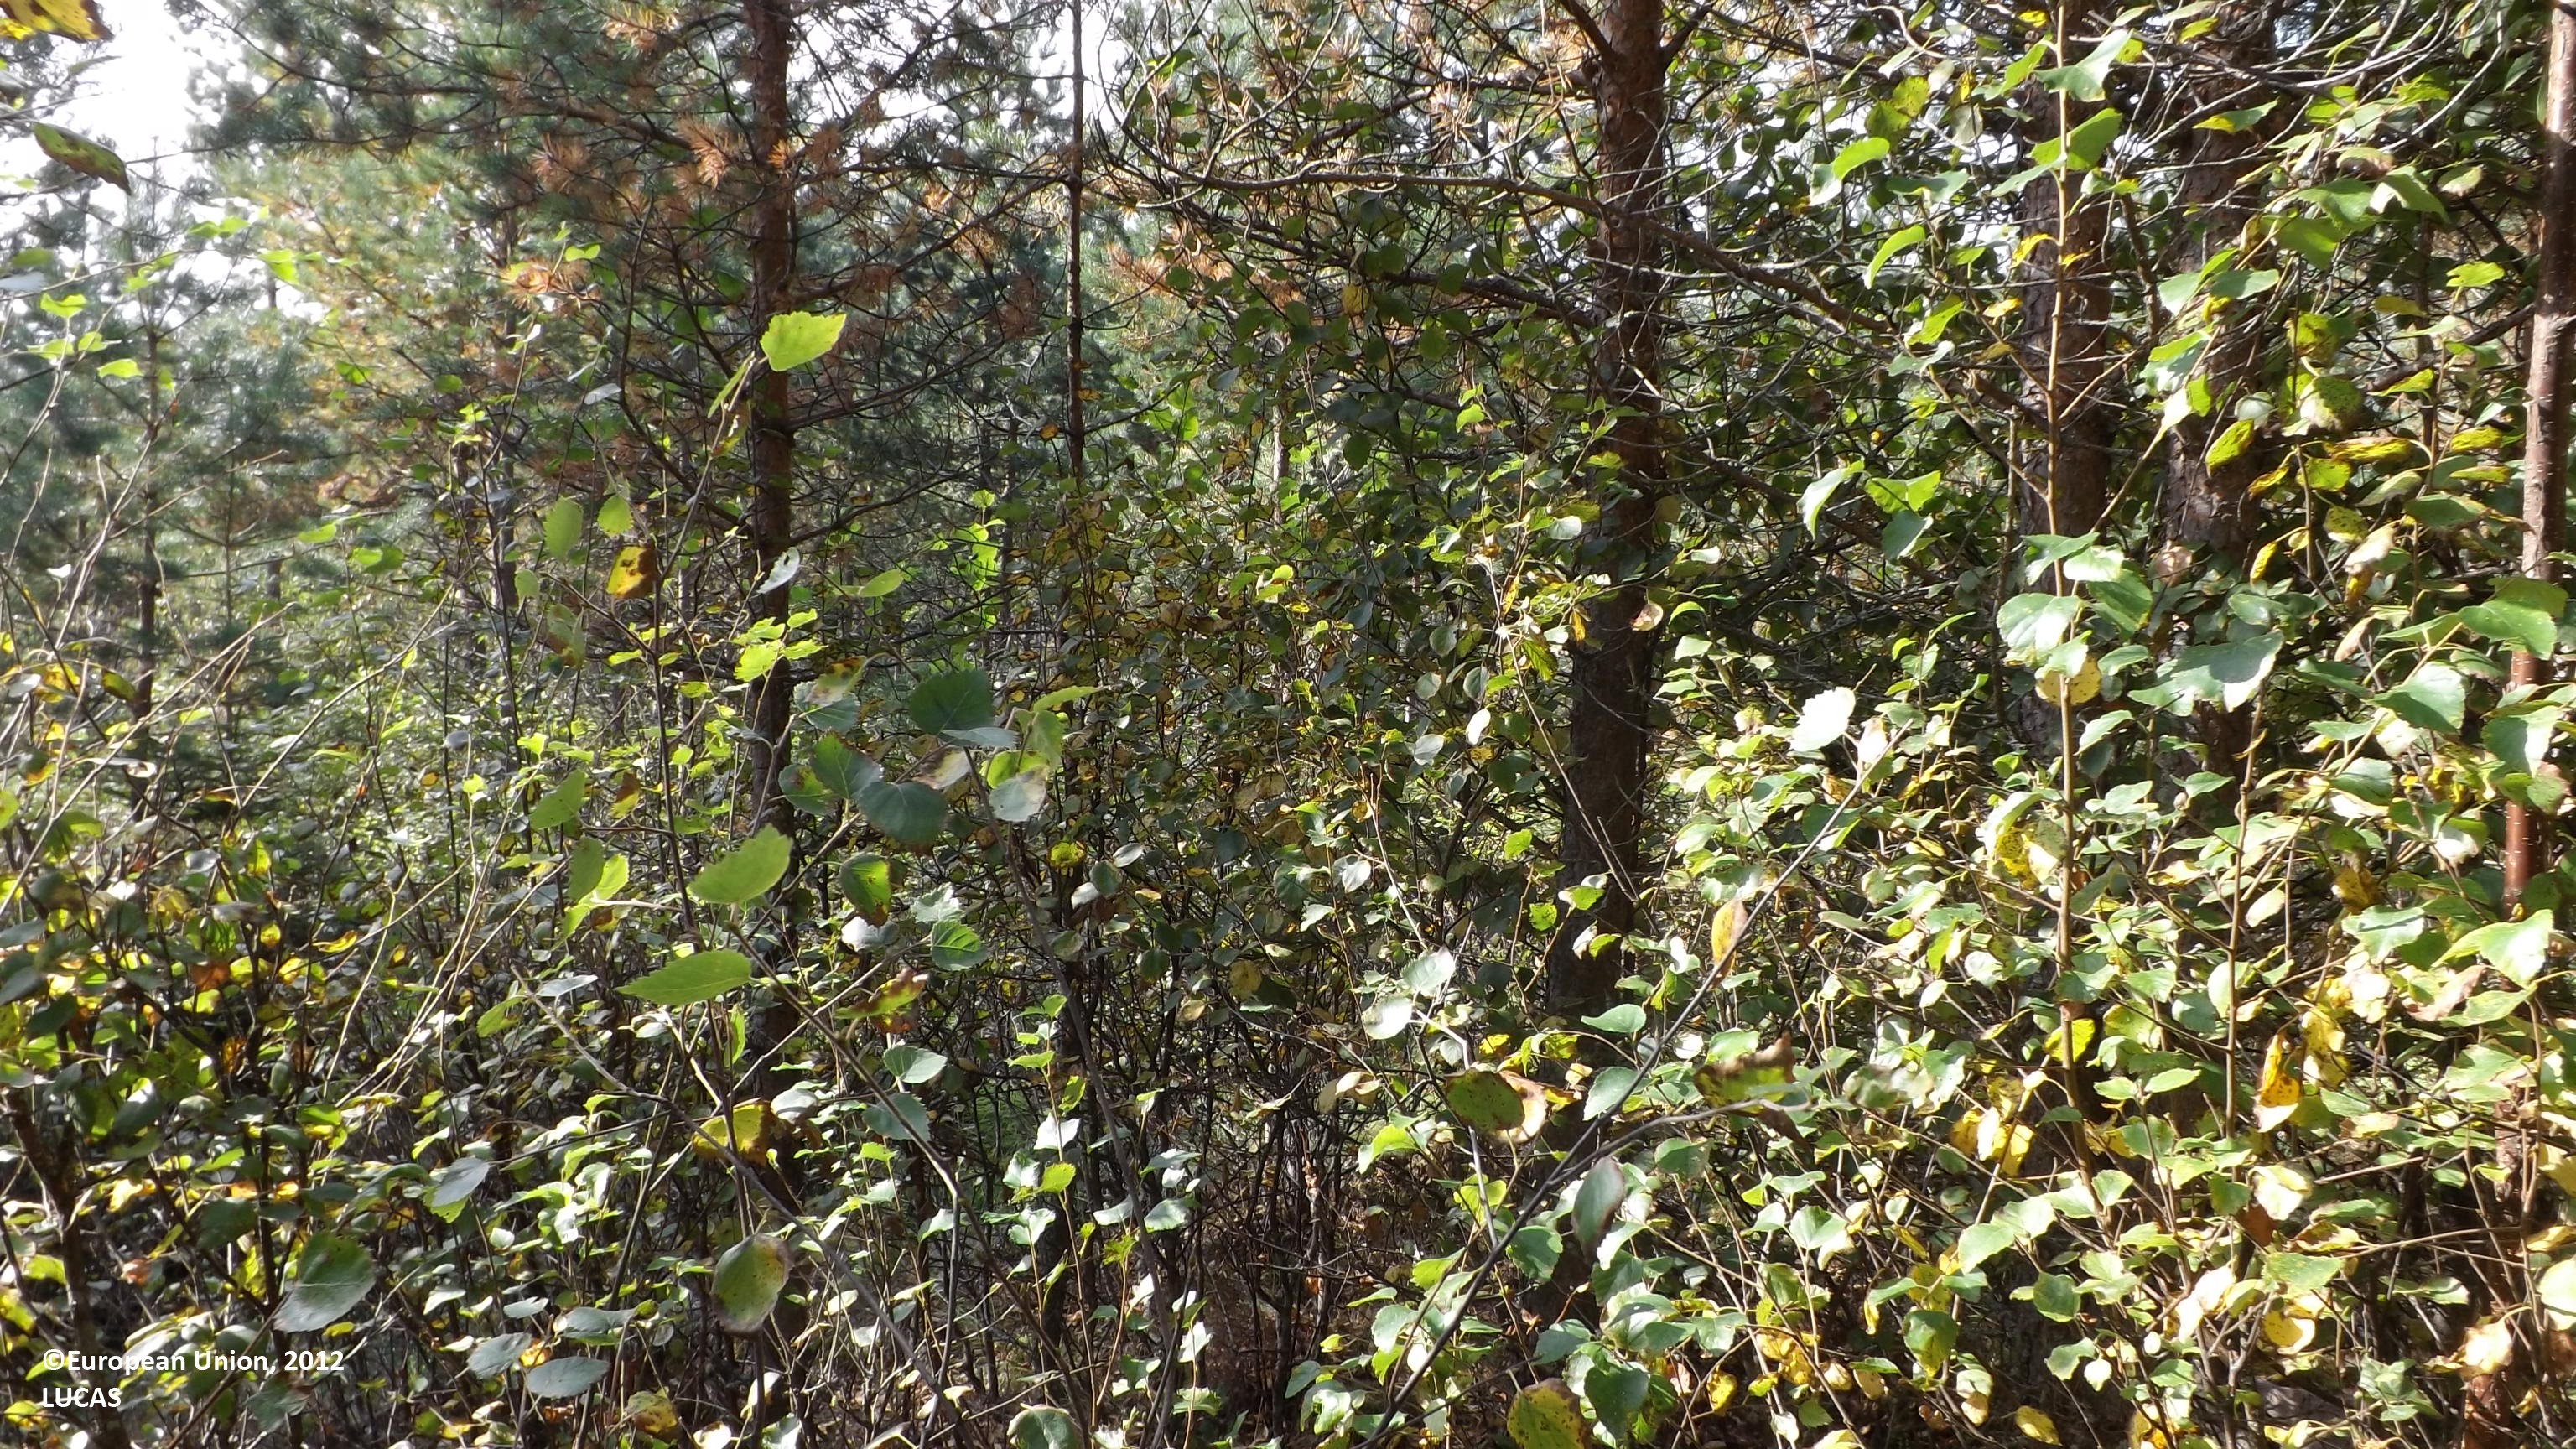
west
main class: Woodland
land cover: Pine dominated coniferous woodland
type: boreal forest
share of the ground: 50 - 75 %
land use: Forestry
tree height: > 5 m
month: August
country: FI
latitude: 63.7347
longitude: 23.6115
